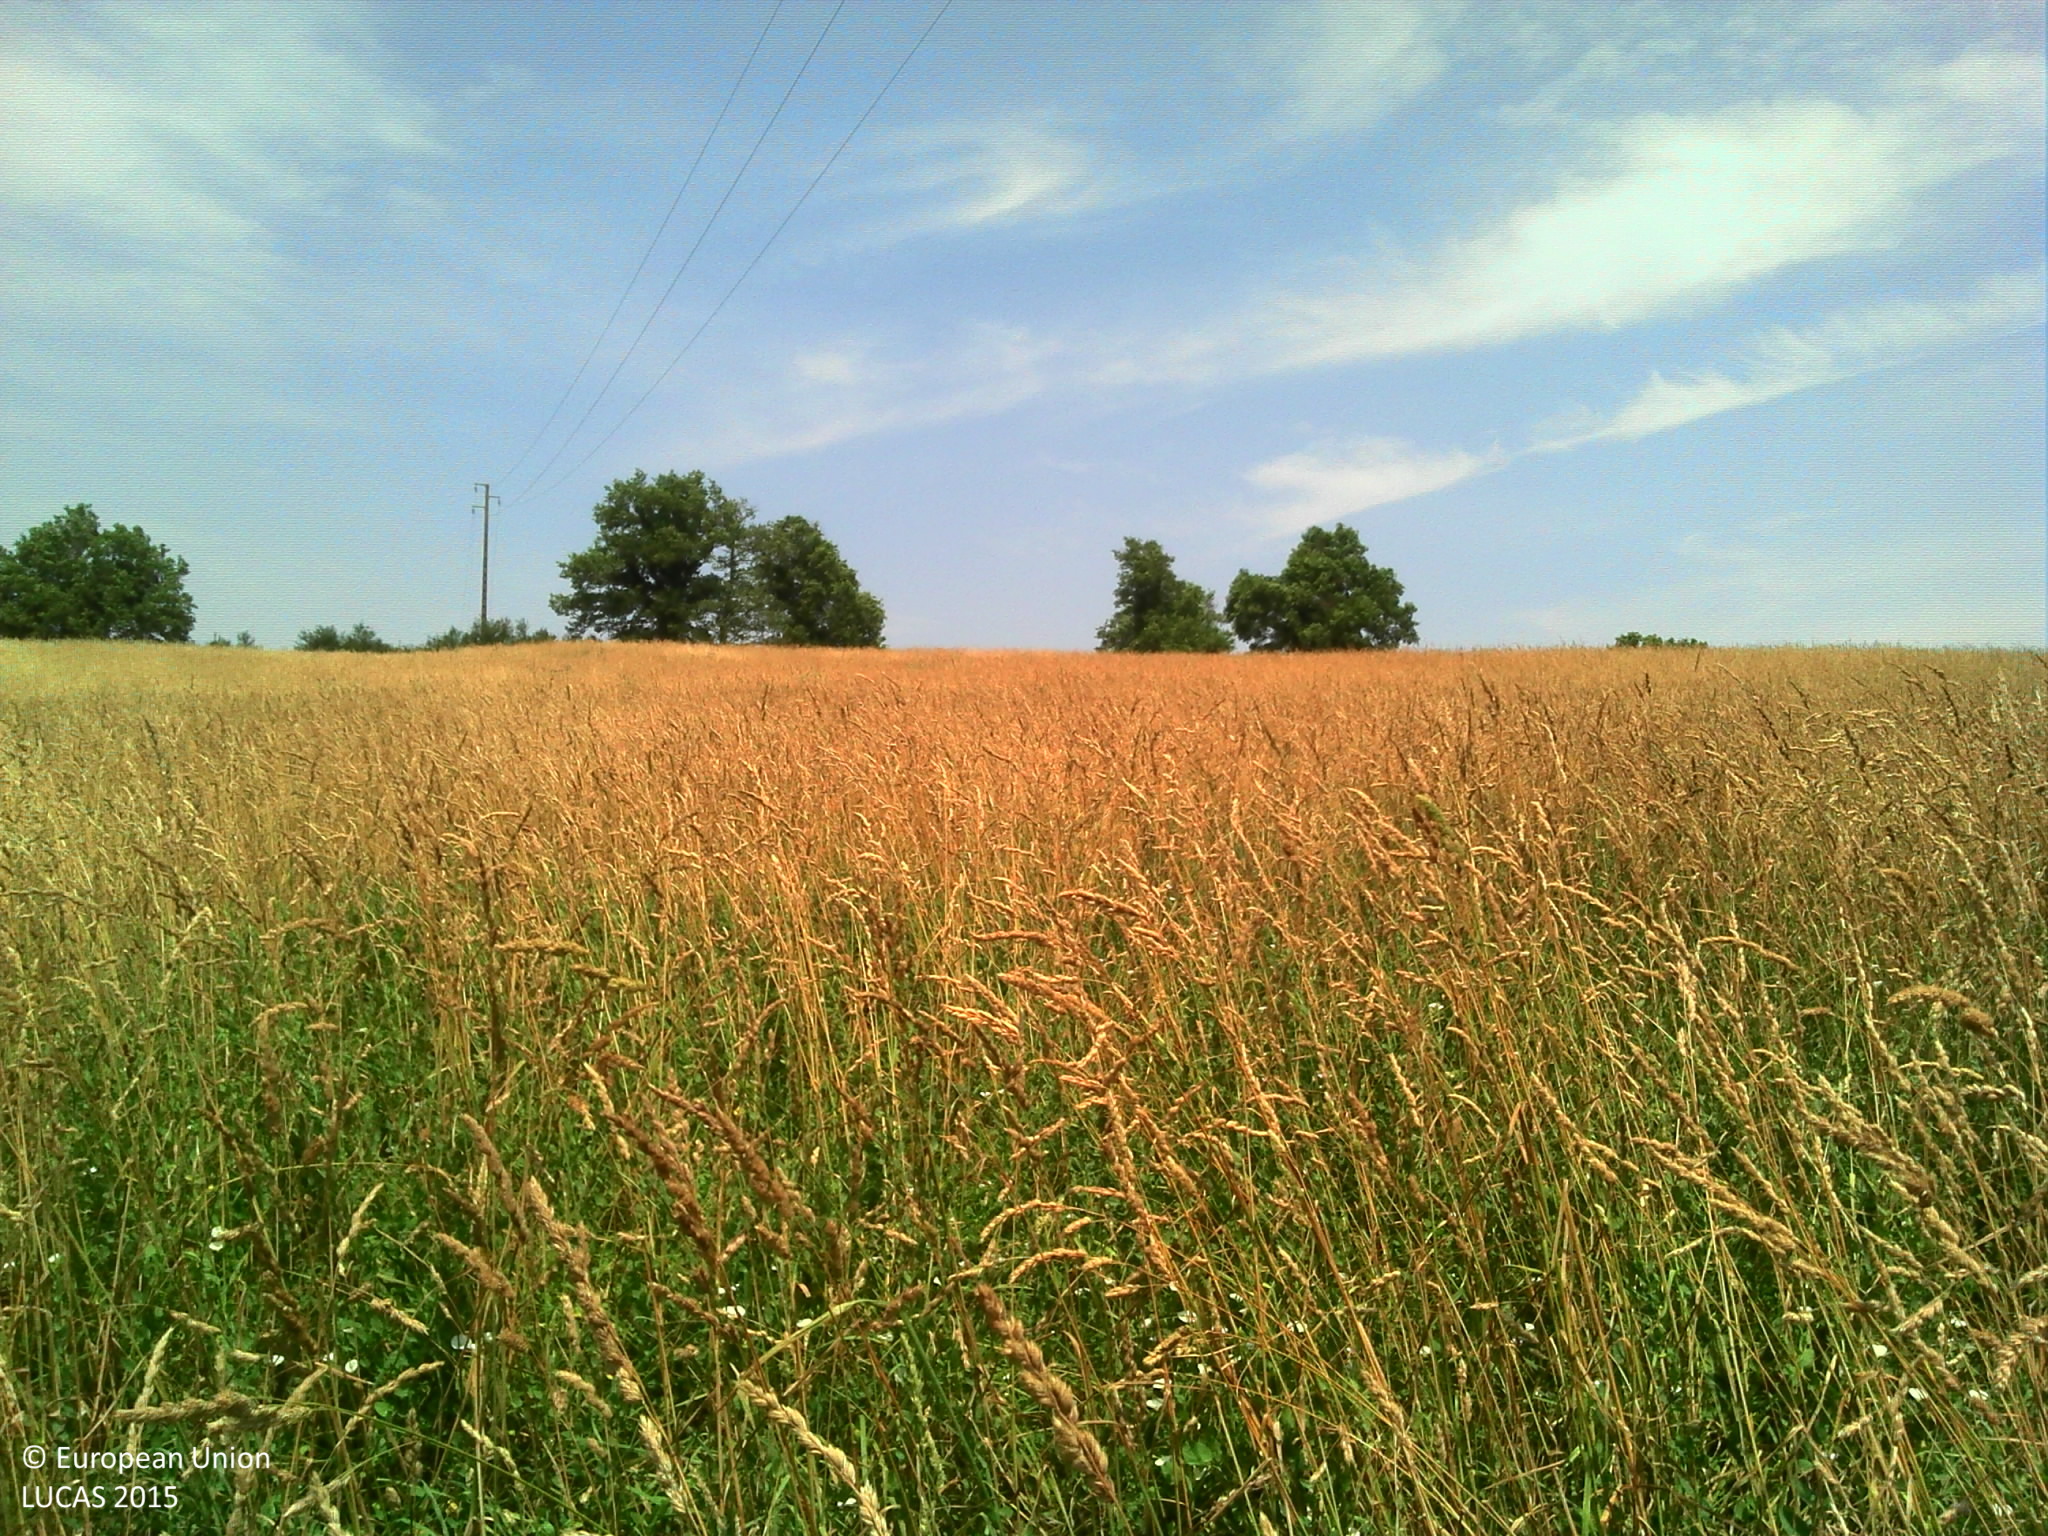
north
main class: Grassland
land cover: Grassland without tree/shrub cover
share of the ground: > 75 %
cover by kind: herbaceous plants 100 %
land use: Agriculture (excluding fallow land and kitchen gardens)
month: July
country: FR
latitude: 46.9728
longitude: -0.9036
